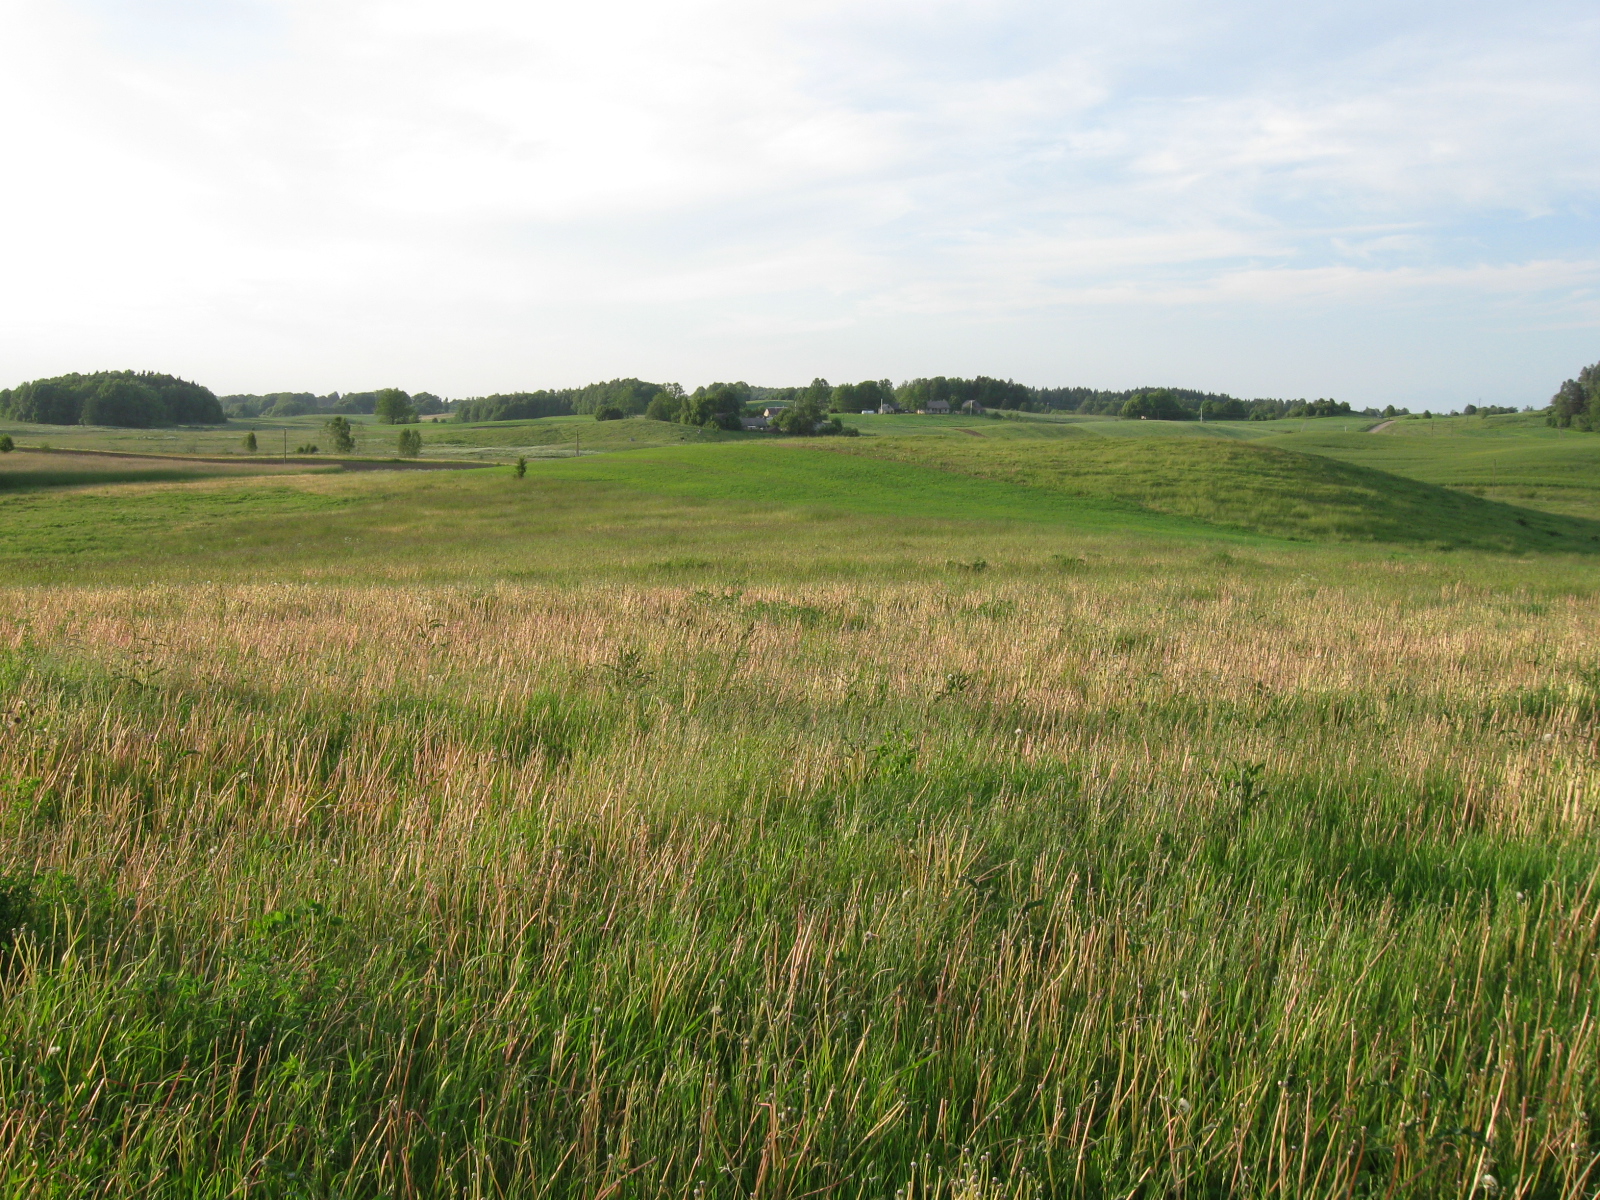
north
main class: Grassland
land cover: Grassland without tree/shrub cover
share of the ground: > 75 %
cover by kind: herbaceous plants 100 %
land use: Agriculture (excluding fallow land and kitchen gardens)
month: June
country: LT
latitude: 54.2533
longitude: 23.6070
